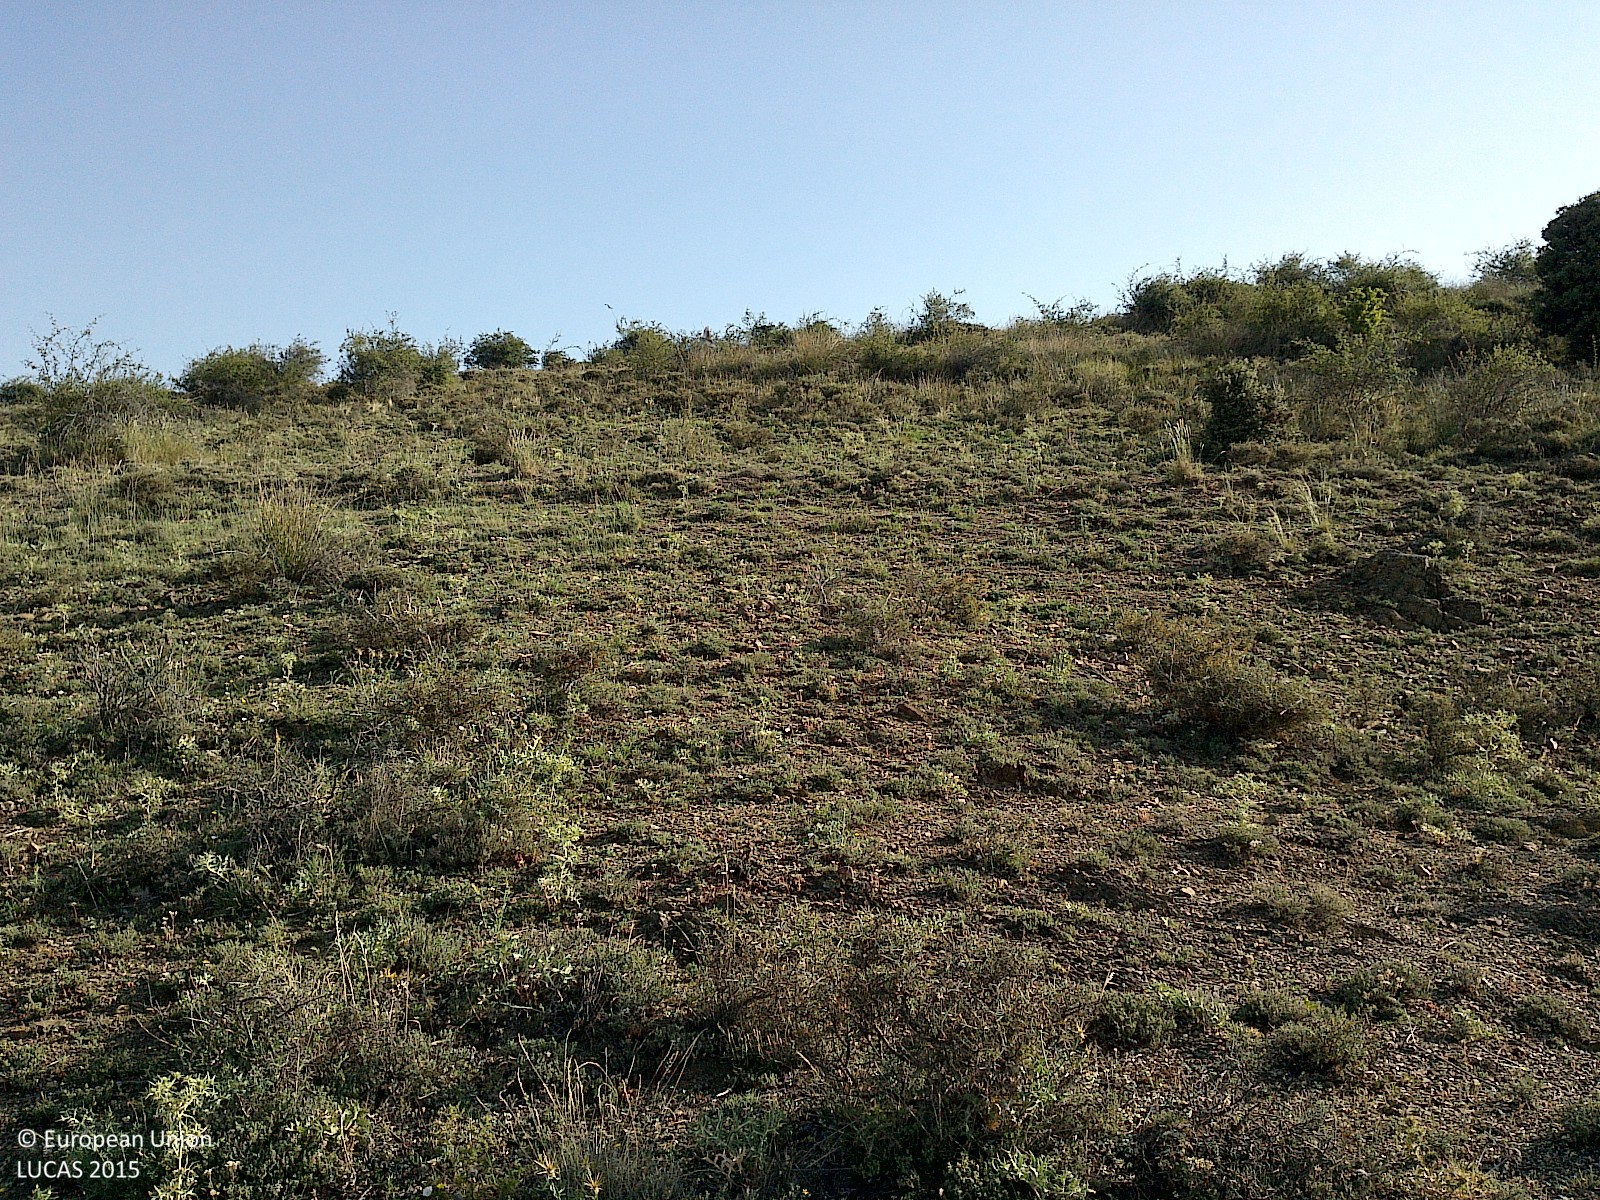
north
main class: Shrubland
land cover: Shrubland without tree cover
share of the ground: 25 - 50 %
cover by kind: consolidated bare surface 50 %, shrubs 25 %, herbaceous plants 10 %, unconsolidated bare surface 10 %, lichens and mosses 5 %
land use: Agriculture (excluding fallow land and kitchen gardens)
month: July
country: ES
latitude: 41.5003
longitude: -1.9977
